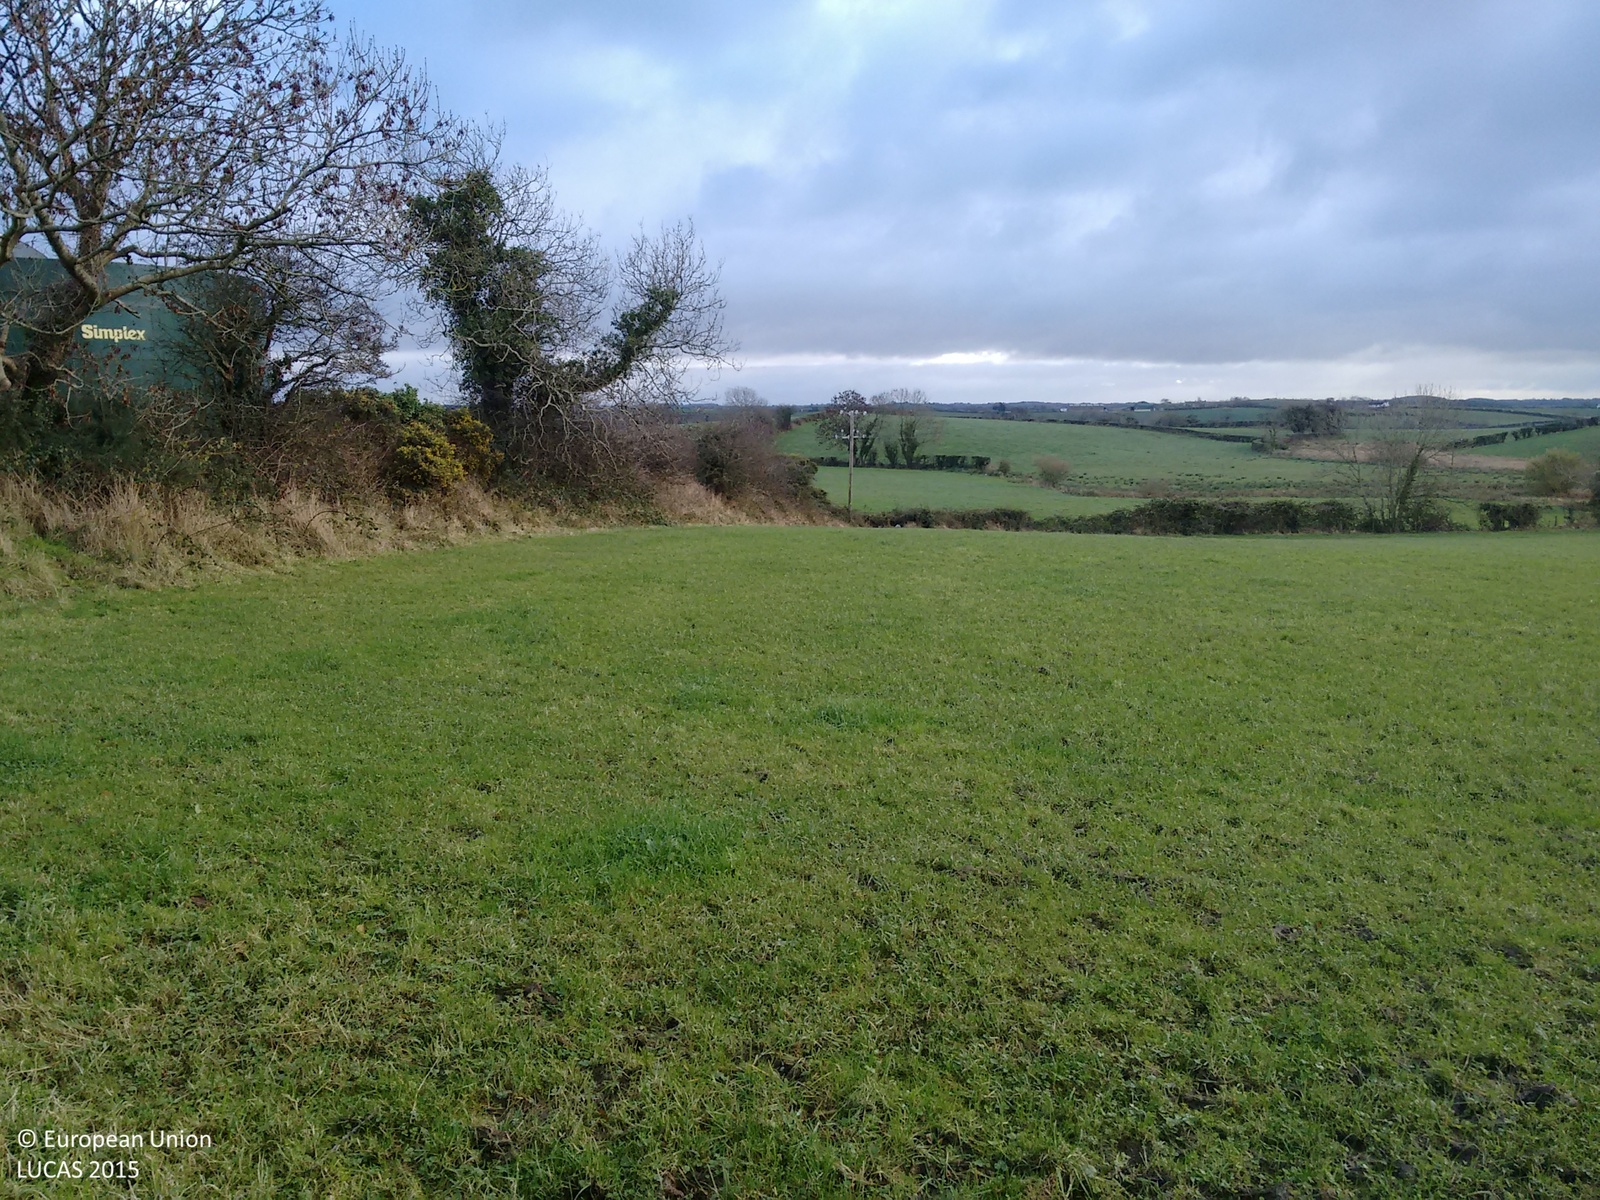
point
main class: Grassland
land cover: Grassland without tree/shrub cover
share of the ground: > 75 %
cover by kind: herbaceous plants 100 %
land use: Agriculture (excluding fallow land and kitchen gardens)
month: November
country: GB
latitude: 54.5940
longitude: -5.6546
